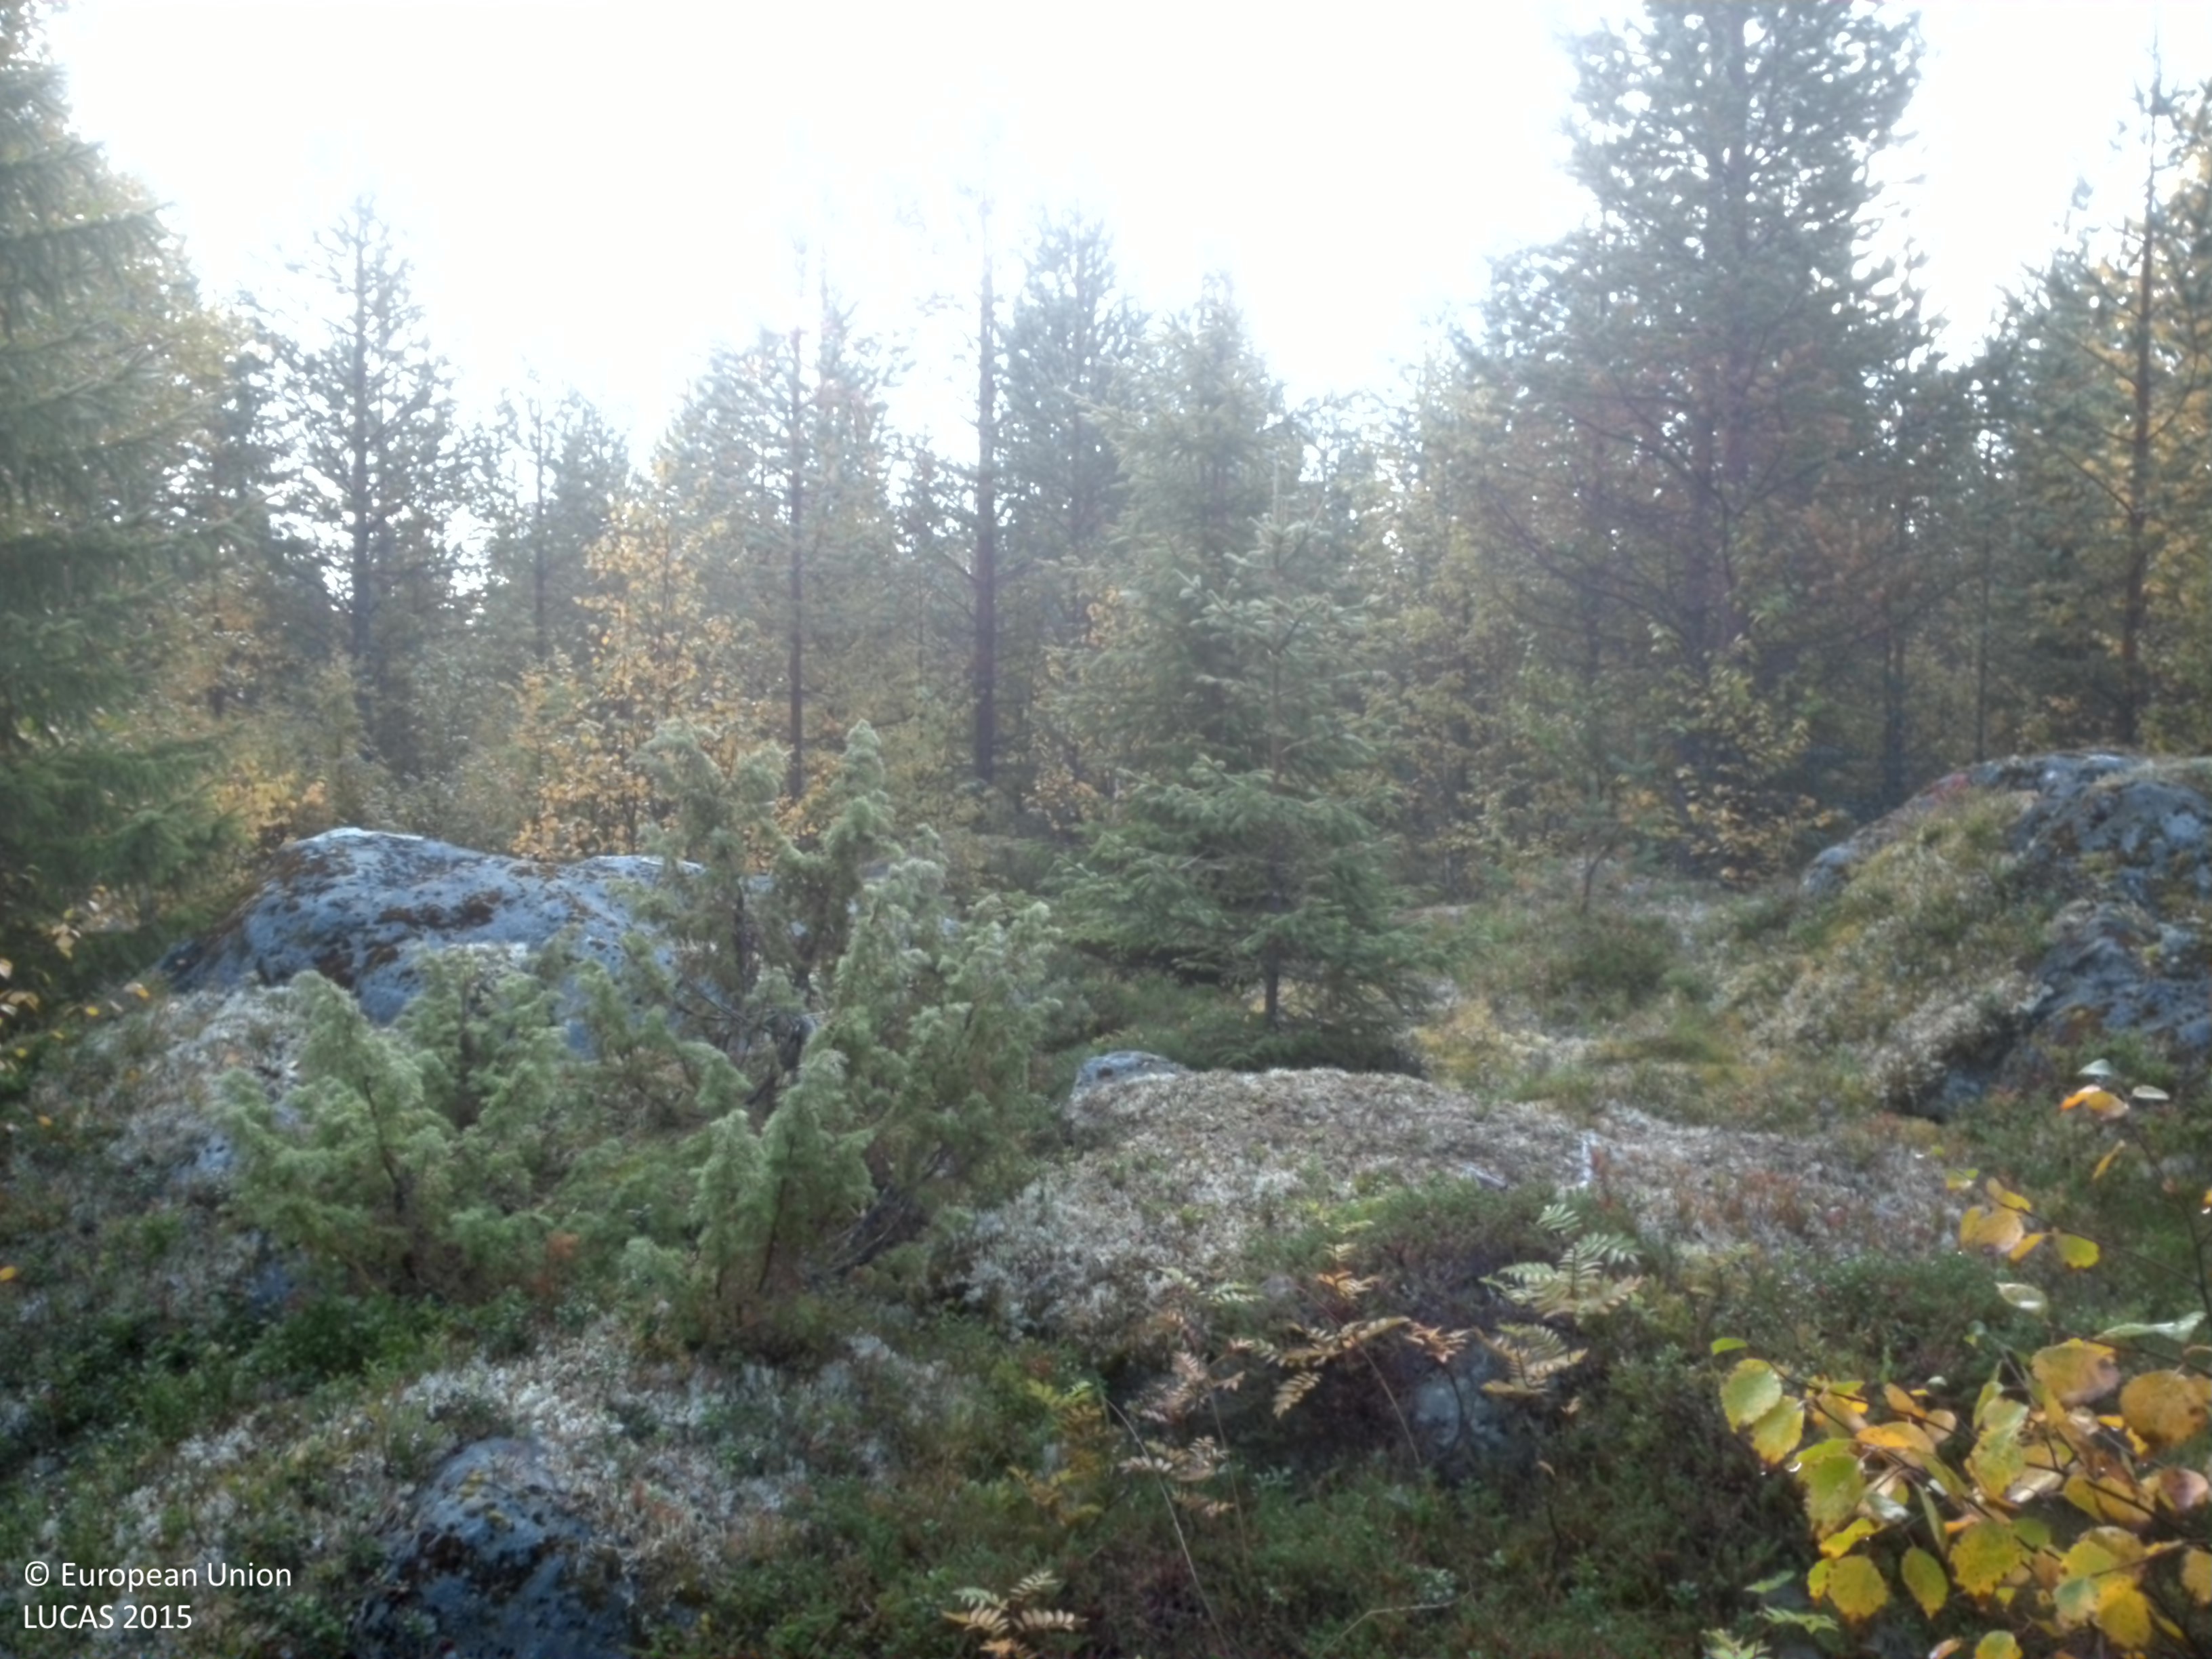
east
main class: Woodland
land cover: Pine dominated mixed woodland
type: boreal forest
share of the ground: 50 - 75 %
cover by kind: coniferous forest trees 45 %, broadleaved forest trees 15 %, shrubs 15 %, lichens and mosses 15 %, herbaceous plants 10 %
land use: Forestry
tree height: > 5 m
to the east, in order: Pine dominated mixed woodland; Tracks; Pine dominated coniferous woodland; Broadleaved woodland; Pine dominated coniferous woodland
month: September
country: SE
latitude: 64.3618
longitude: 19.8968
